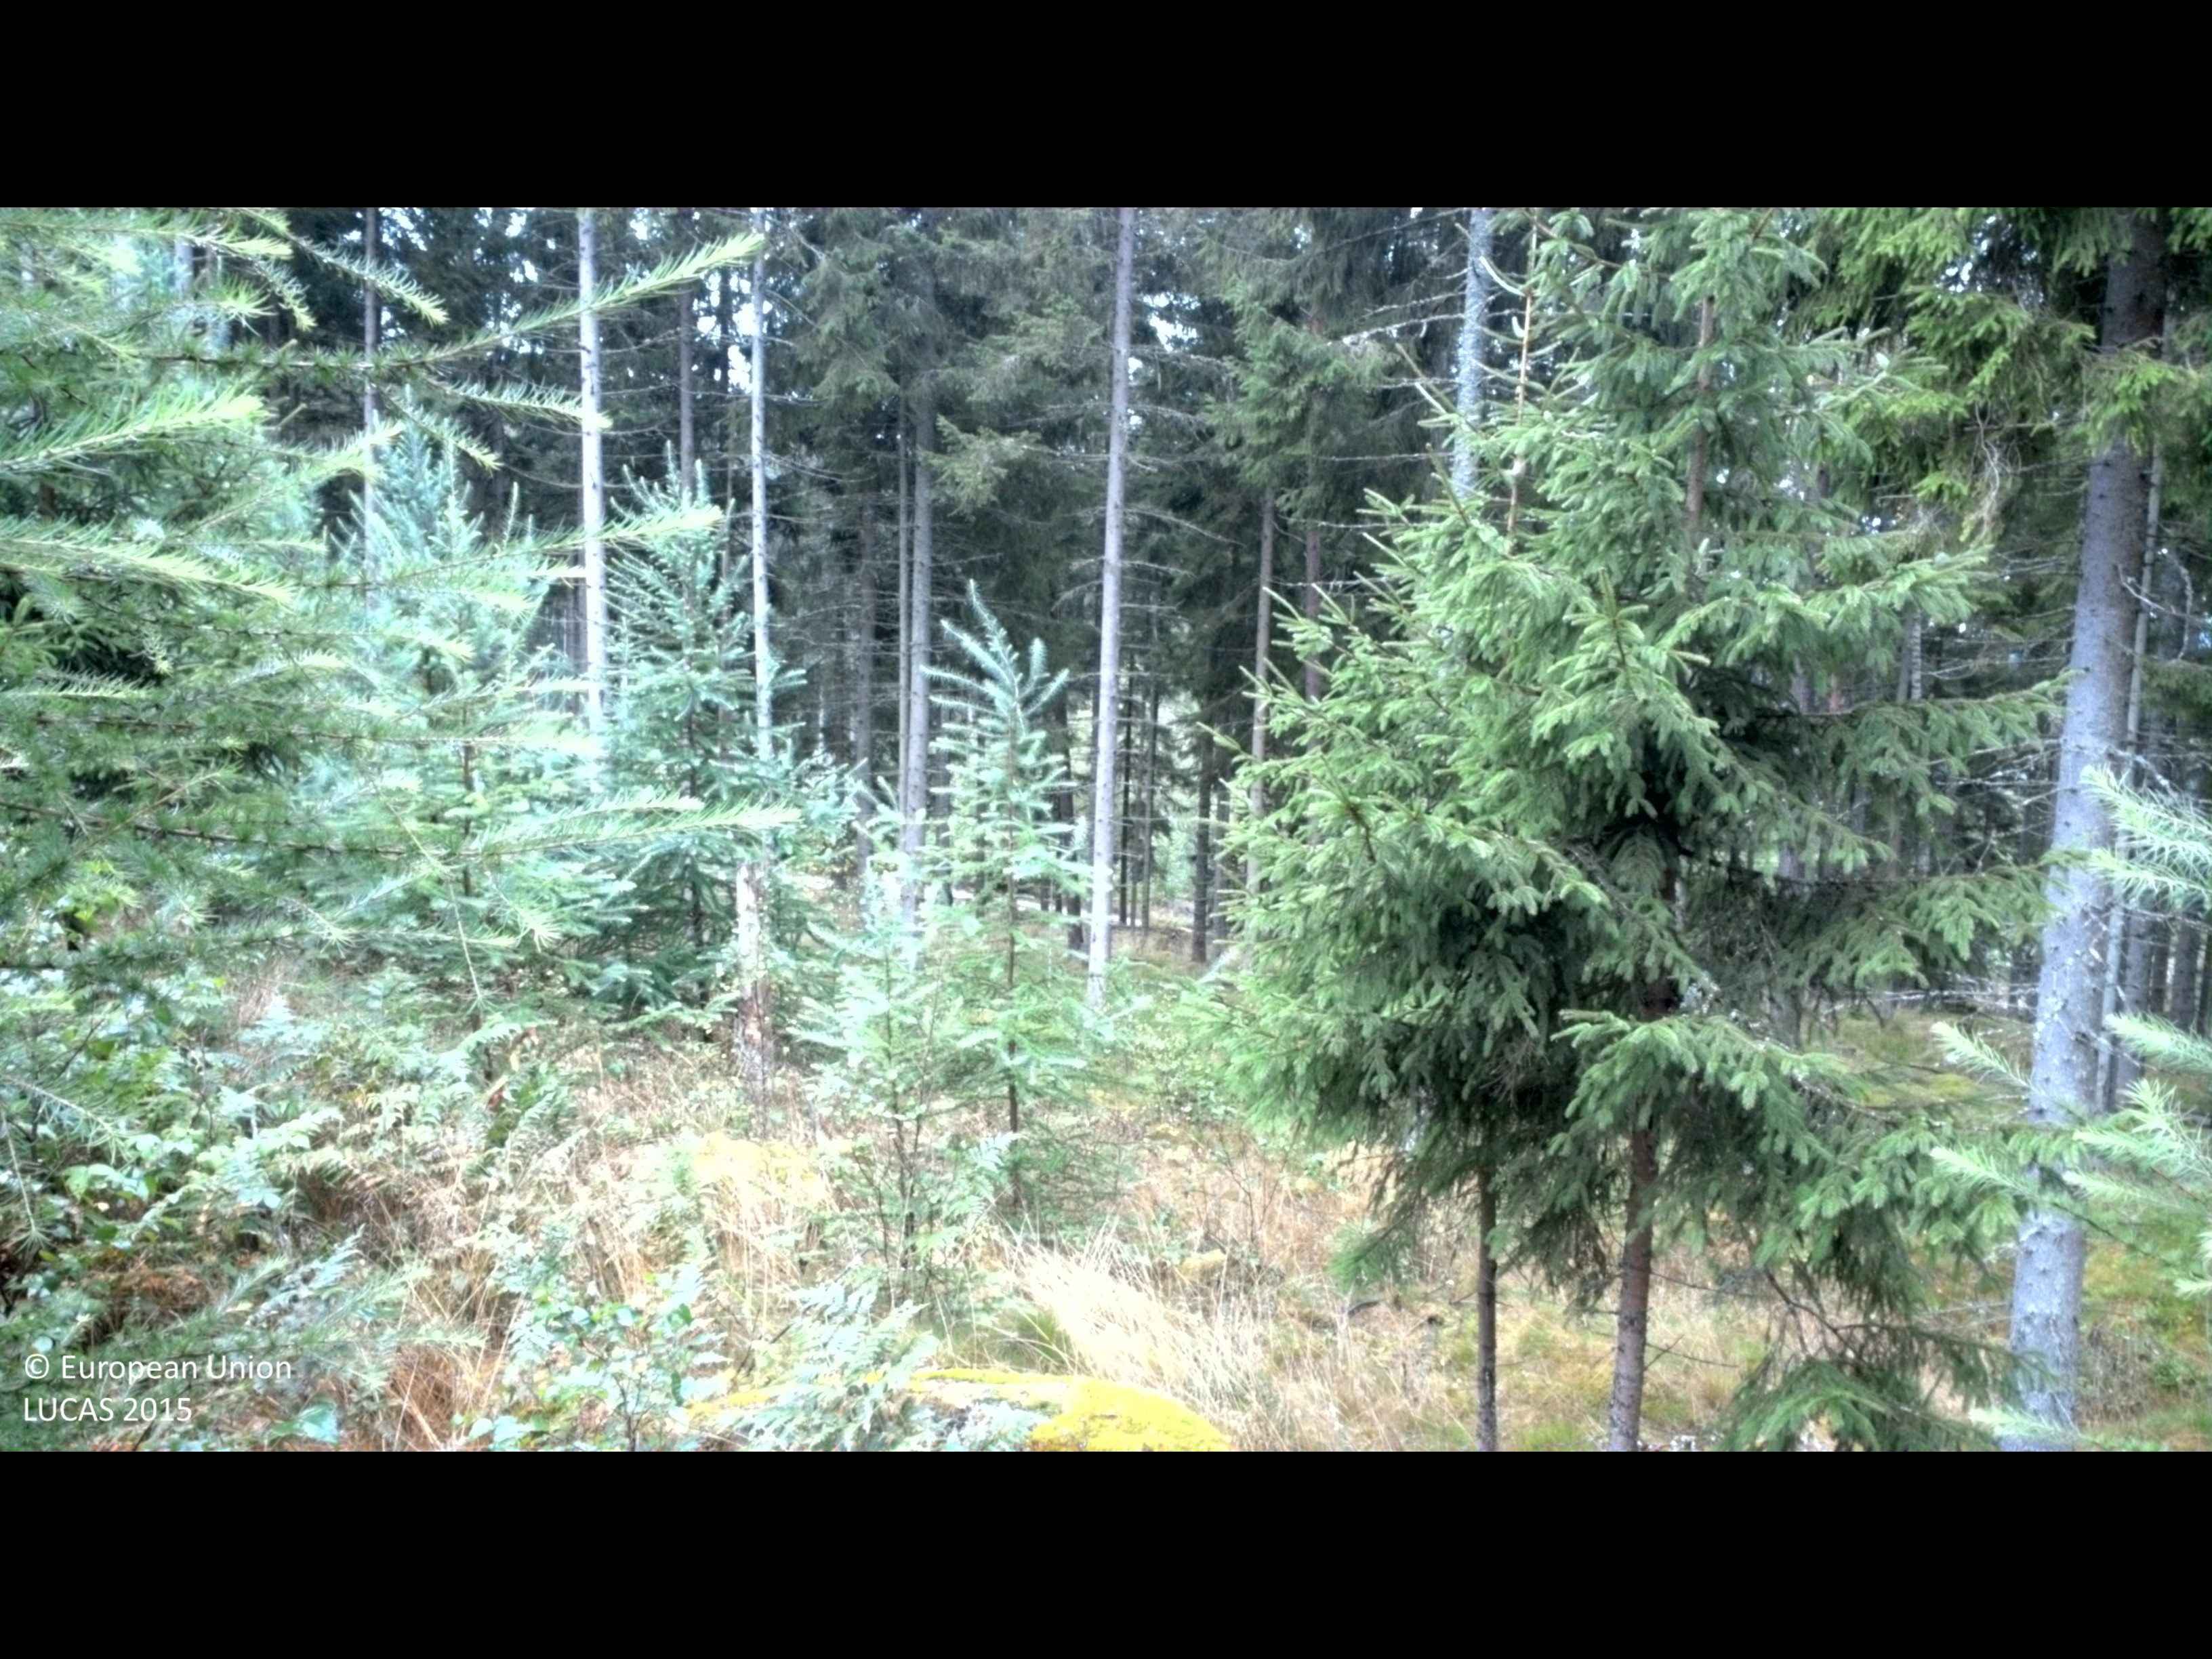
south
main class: Woodland
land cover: Other mixed woodland
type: boreal forest
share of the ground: 50 - 75 %
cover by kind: coniferous forest trees 35 %, broadleaved forest trees 35 %, shrubs 15 %, herbaceous plants 15 %
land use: Forestry
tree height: < 5 m
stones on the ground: 10 - 25 %
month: August
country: SE
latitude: 57.3366
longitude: 13.8334
